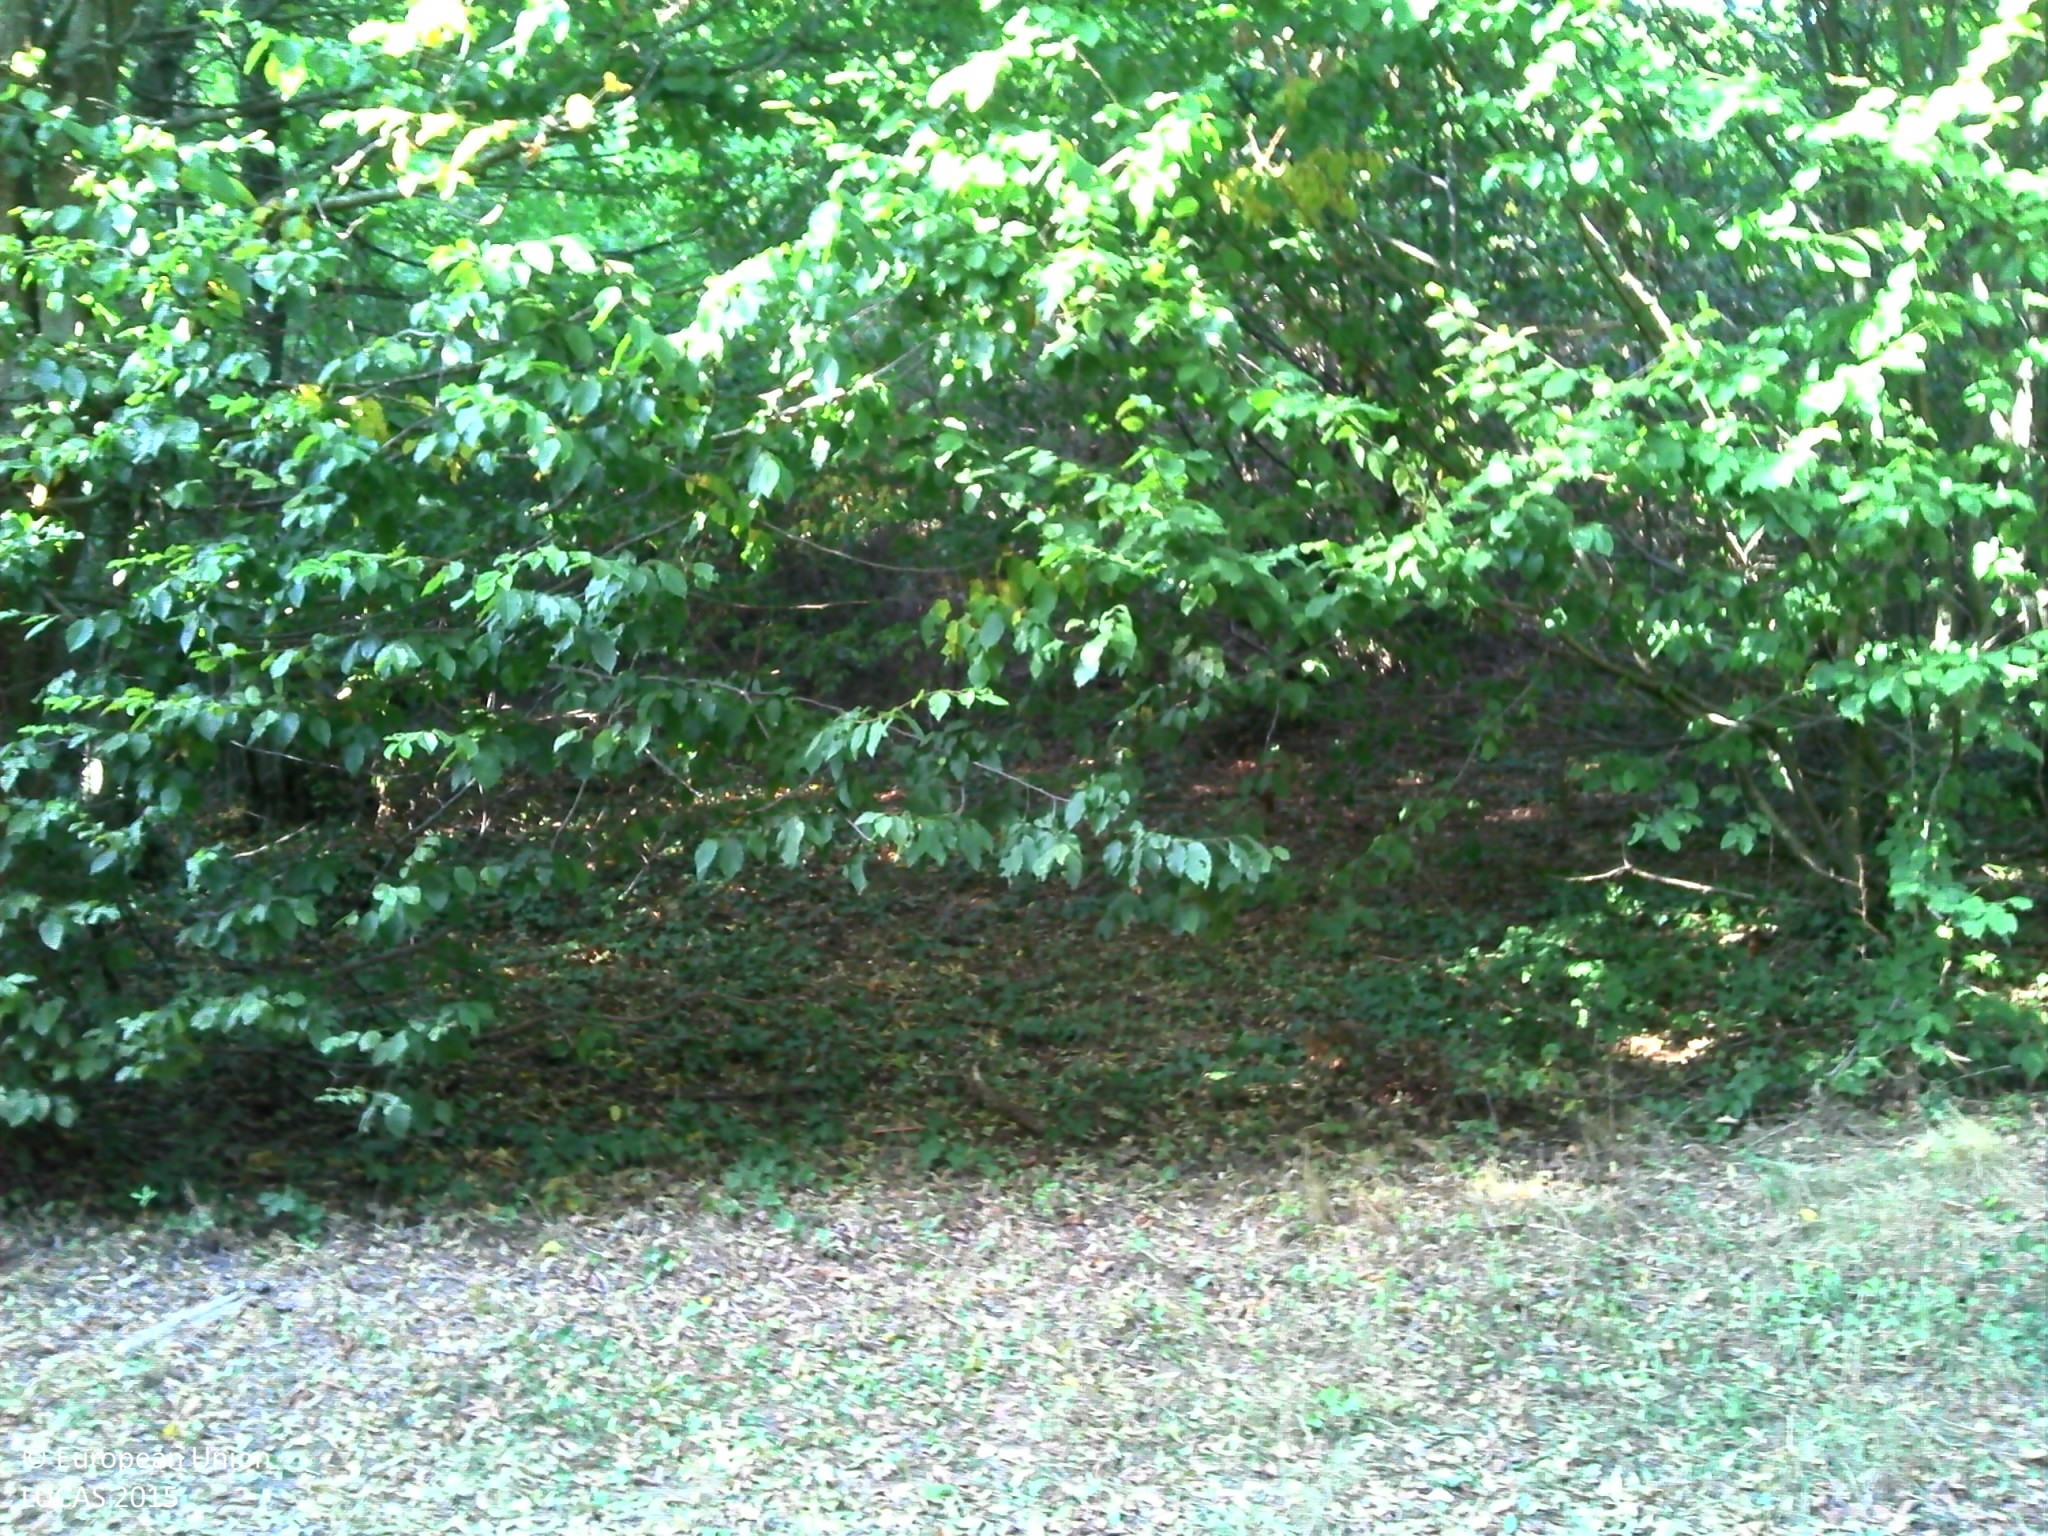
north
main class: Woodland
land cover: Broadleaved woodland
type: mesophytic deciduous forest
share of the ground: > 75 %
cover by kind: broadleaved forest trees 85 %, herbaceous plants 10 %, consolidated bare surface 5 %
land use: Forestry
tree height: > 5 m
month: August
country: FR
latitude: 45.7711
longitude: 5.1301
